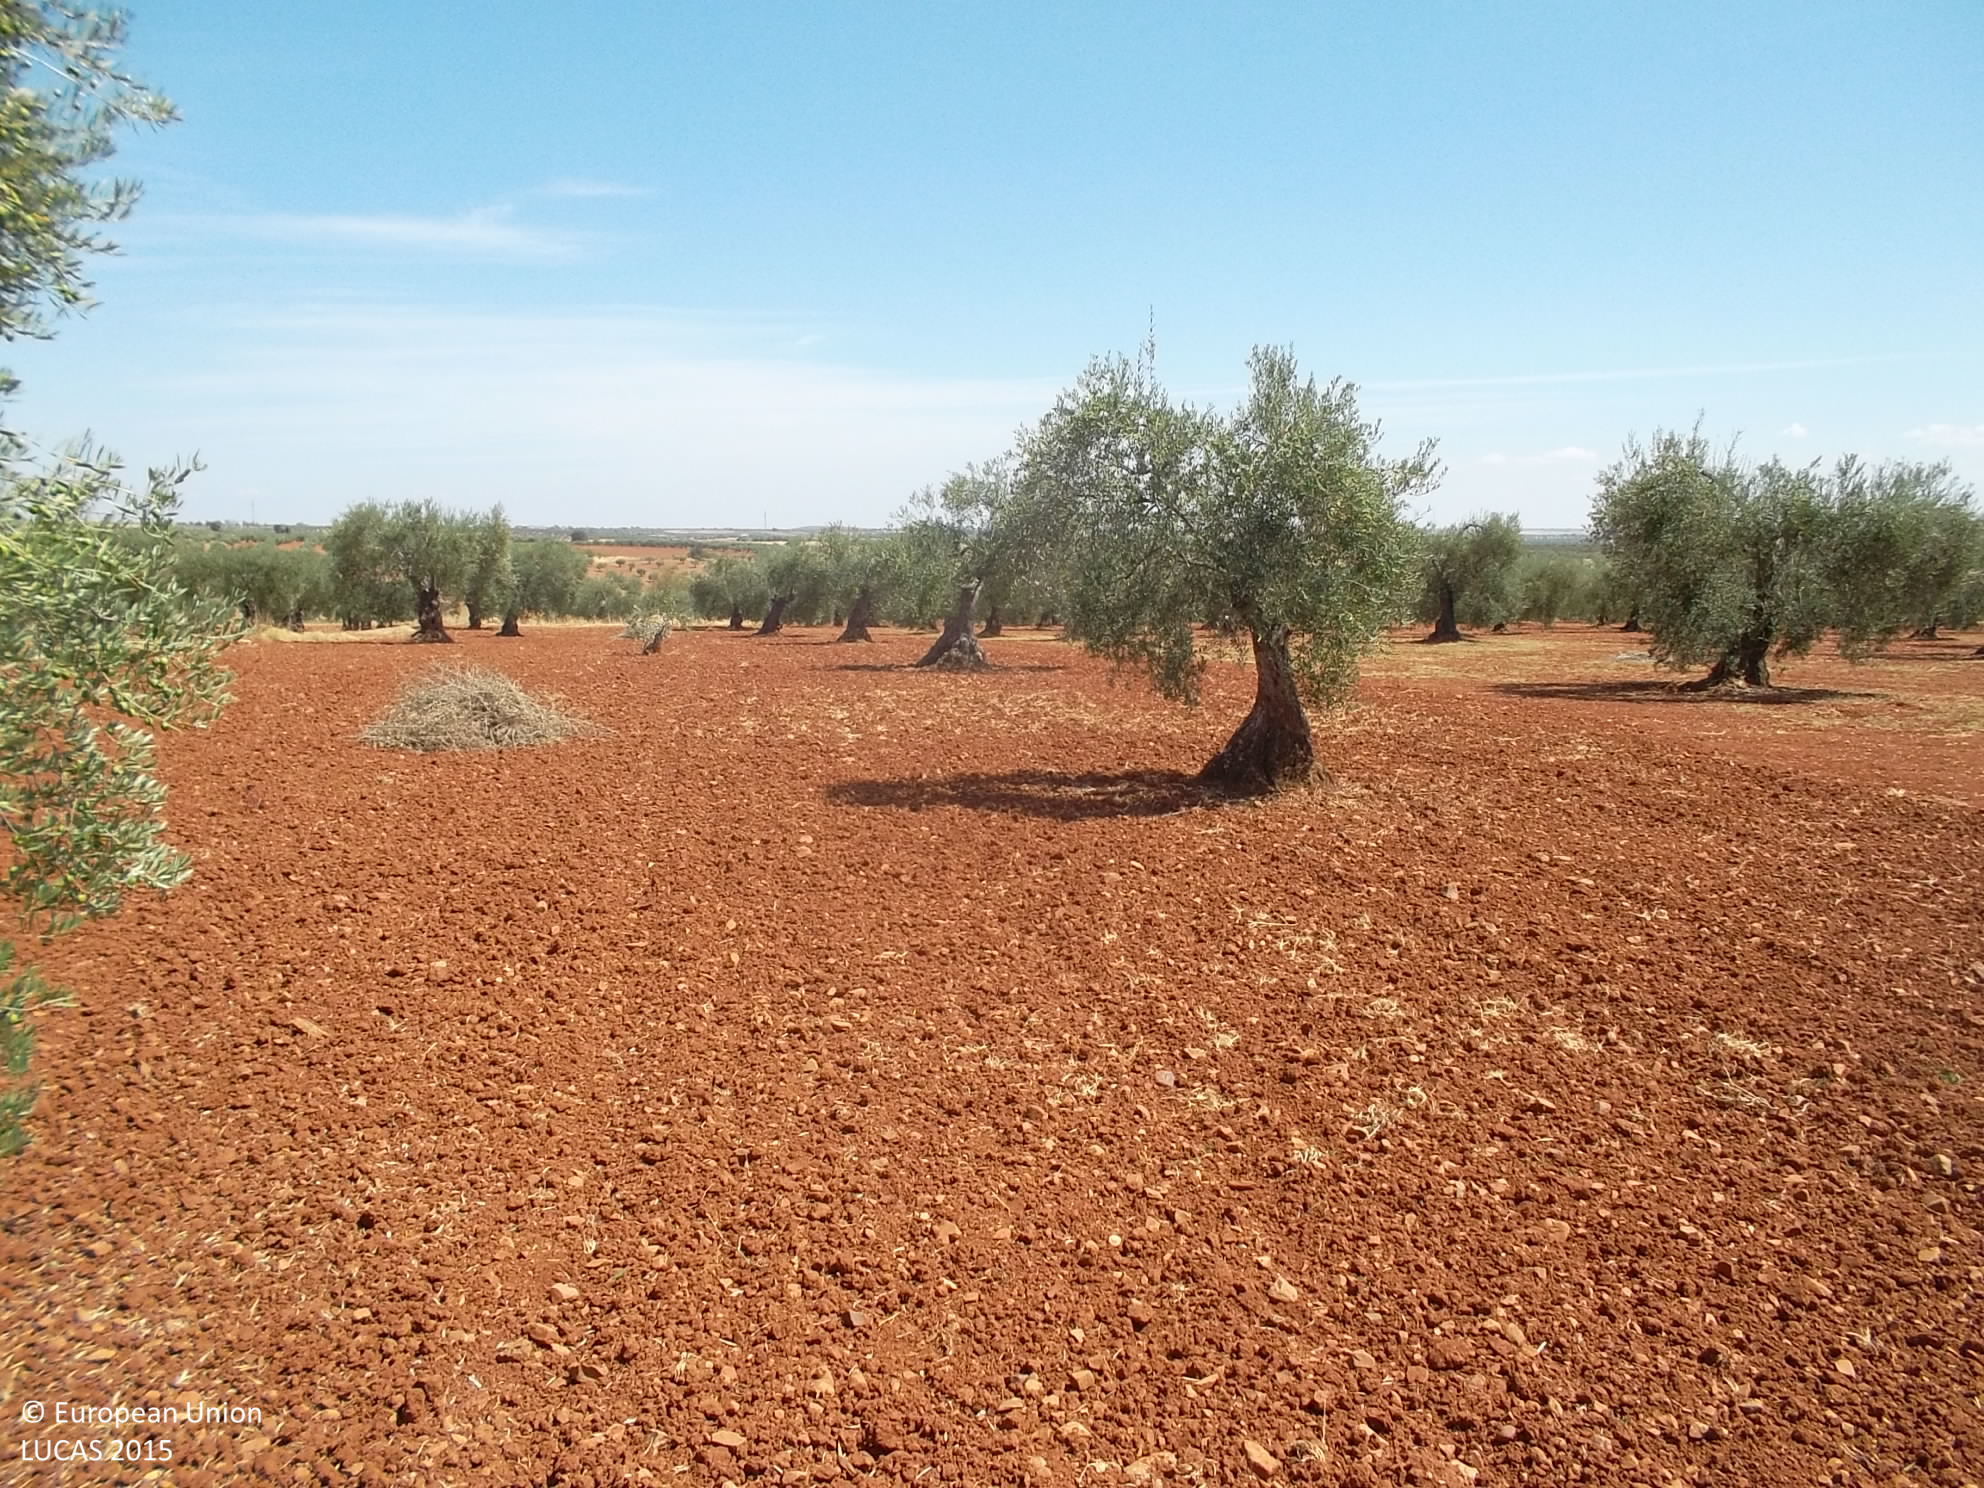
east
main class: Cropland
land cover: Olive groves
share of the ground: 10 - 25 %
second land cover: Other bare soil
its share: > 75 %
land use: Agriculture (excluding fallow land and kitchen gardens)
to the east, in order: Olive groves; Other bare soil; Tracks; Vineyards
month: September
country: ES
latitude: 38.3680
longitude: -6.3580
